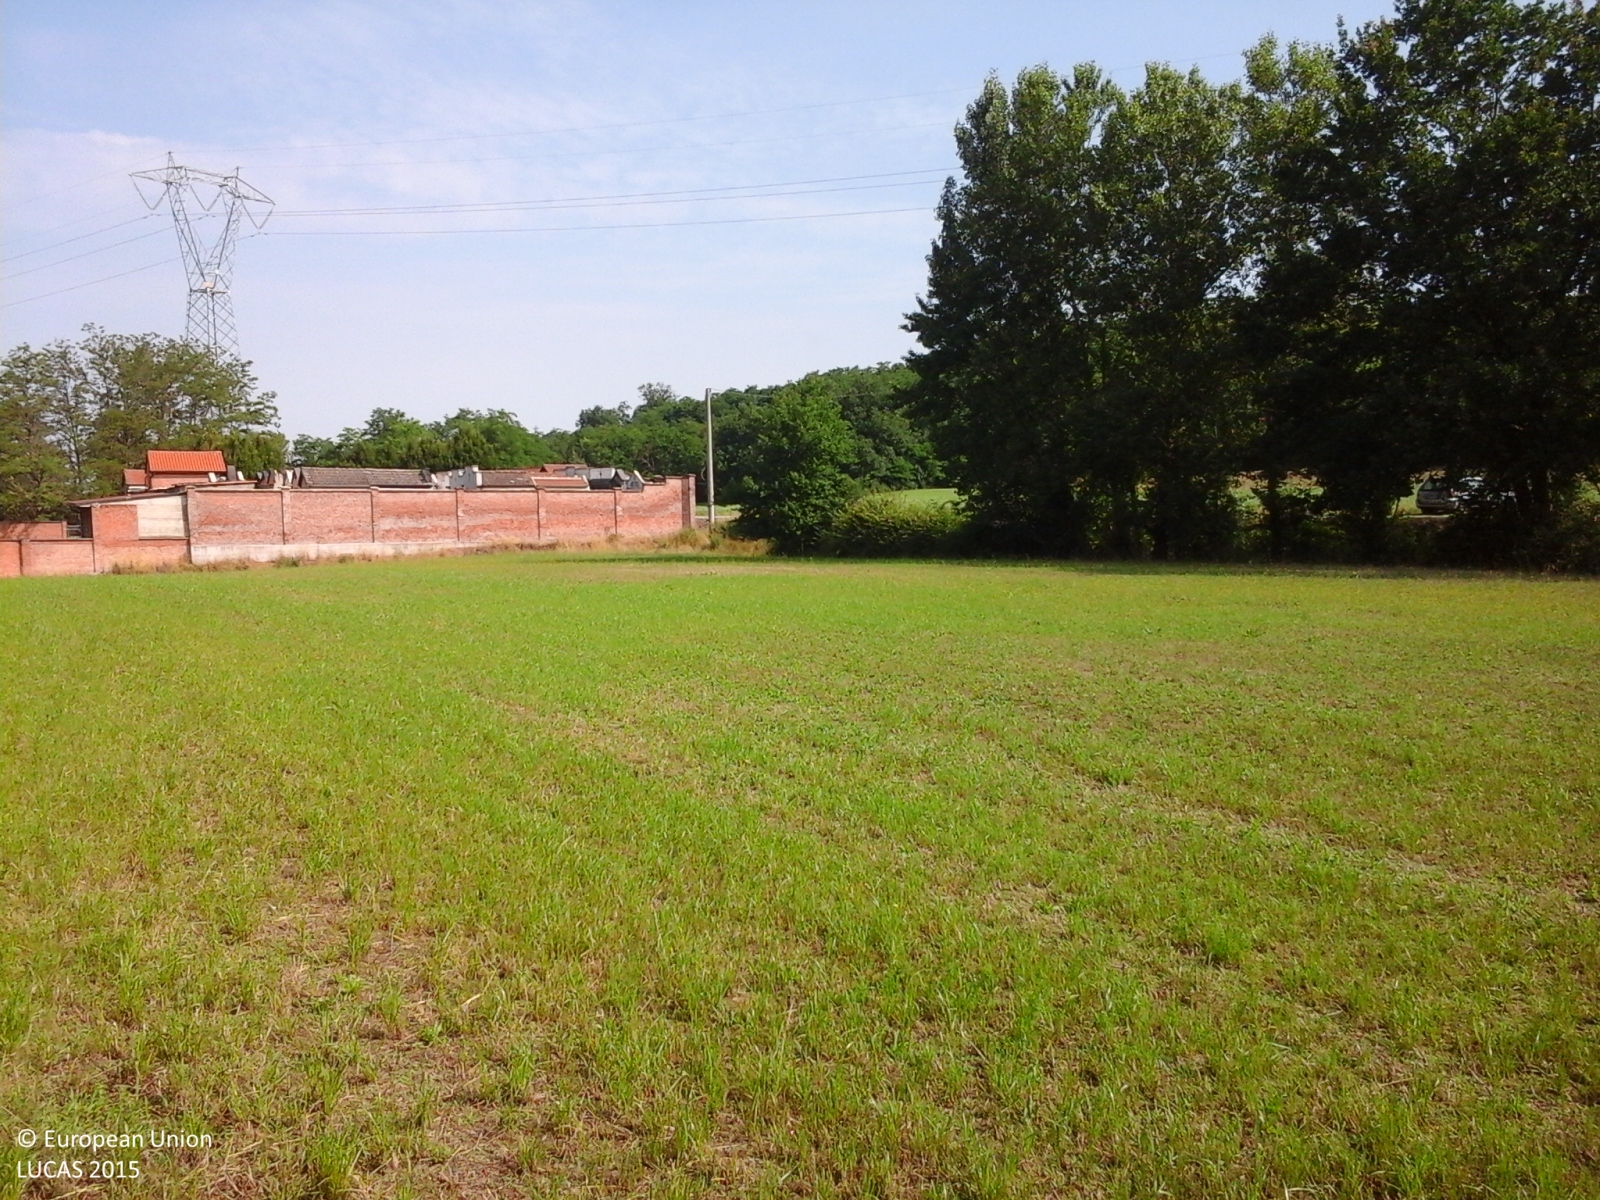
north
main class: Cropland
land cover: Temporary grasslands
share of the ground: > 75 %
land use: Agriculture (excluding fallow land and kitchen gardens)
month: June
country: IT
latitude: 44.7395
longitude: 8.7271
